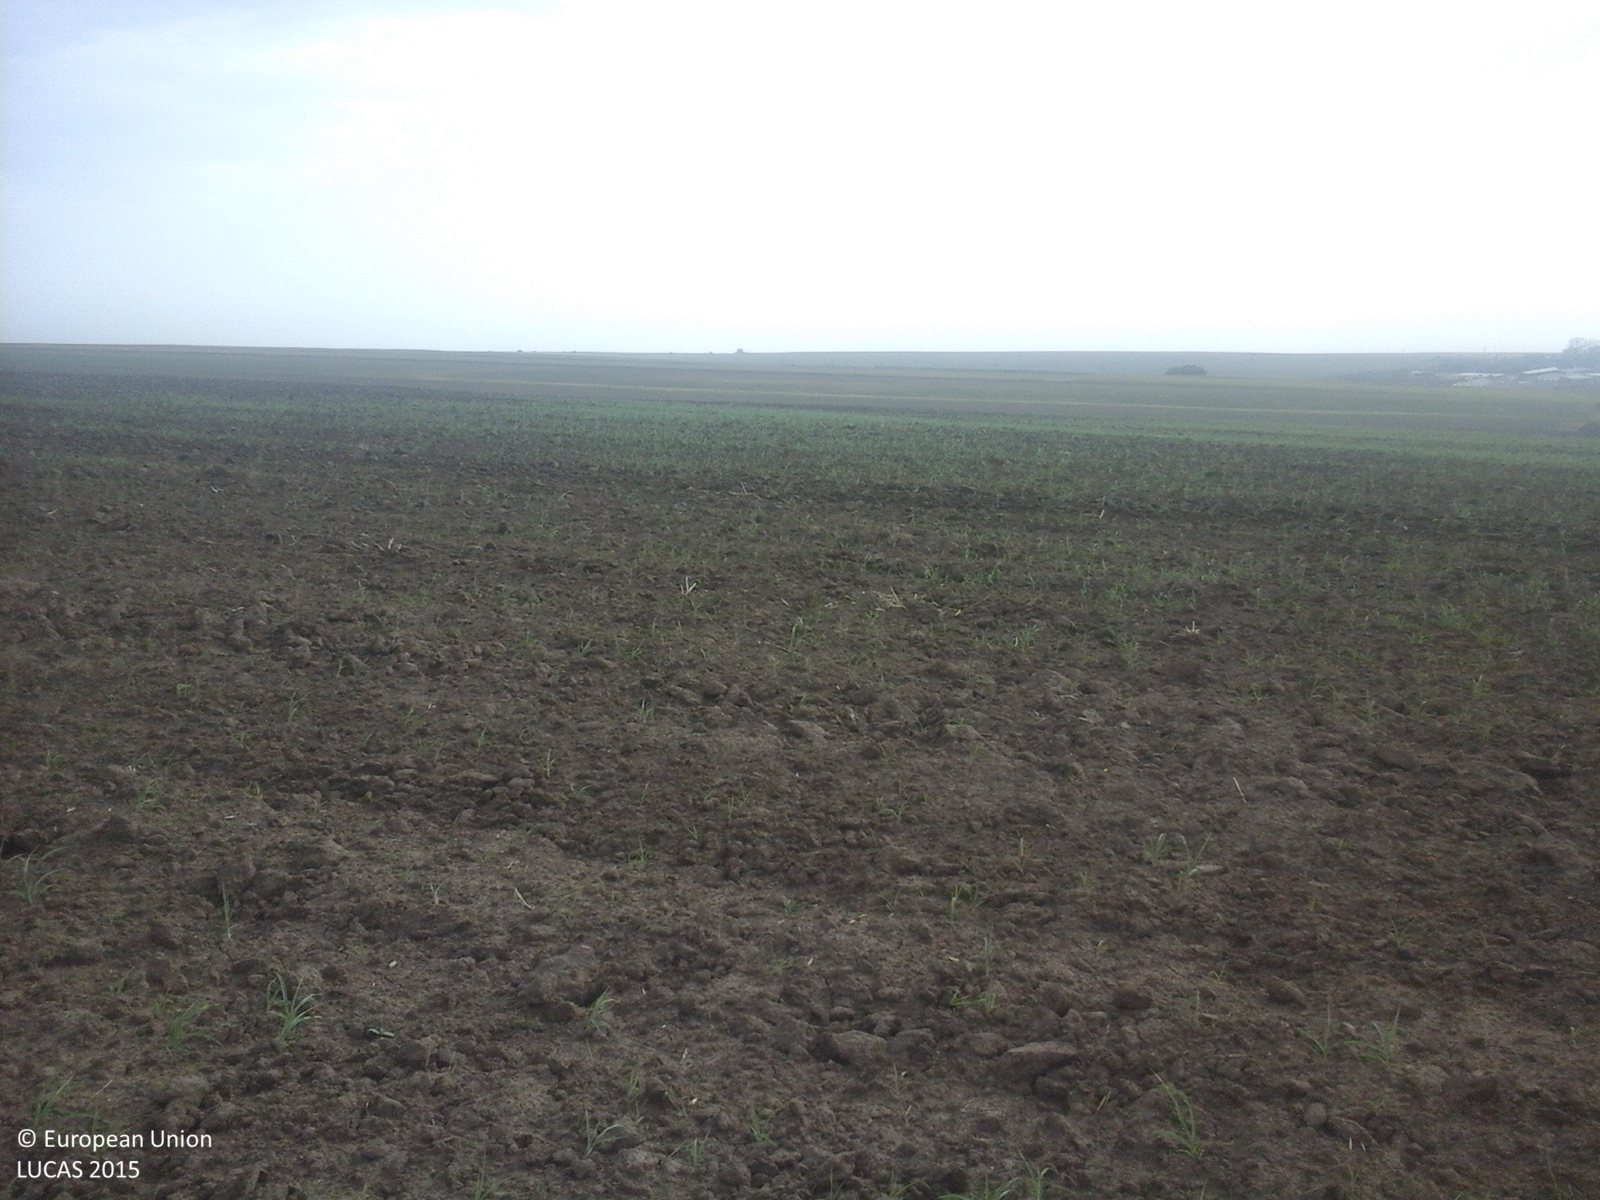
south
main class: Cropland
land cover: Barley
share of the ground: < 10 %
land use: Agriculture (excluding fallow land and kitchen gardens)
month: August
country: RO
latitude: 44.1497
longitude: 28.1750
